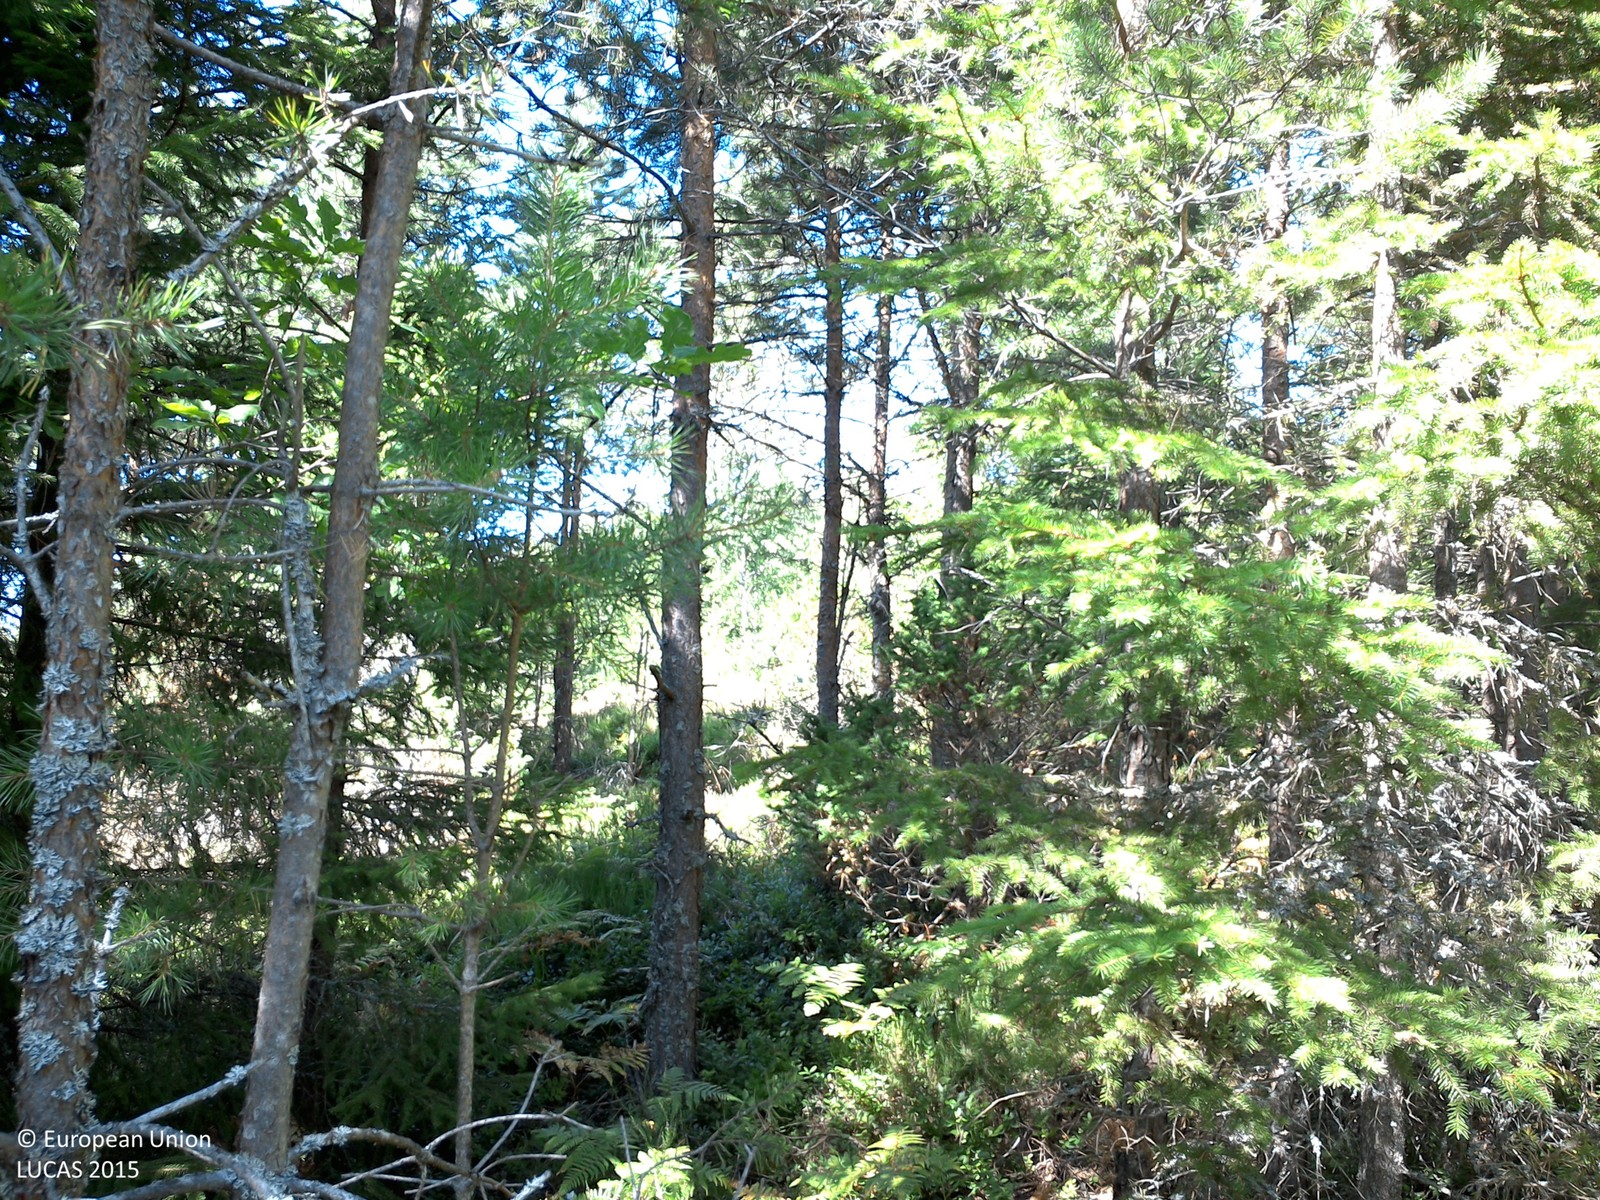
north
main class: Woodland
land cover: Pine dominated coniferous woodland
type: boreal forest
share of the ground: 50 - 75 %
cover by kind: coniferous forest trees 60 %, herbaceous plants 40 %
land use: Forestry
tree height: > 5 m
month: August
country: SE
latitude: 57.8652
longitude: 15.6766
